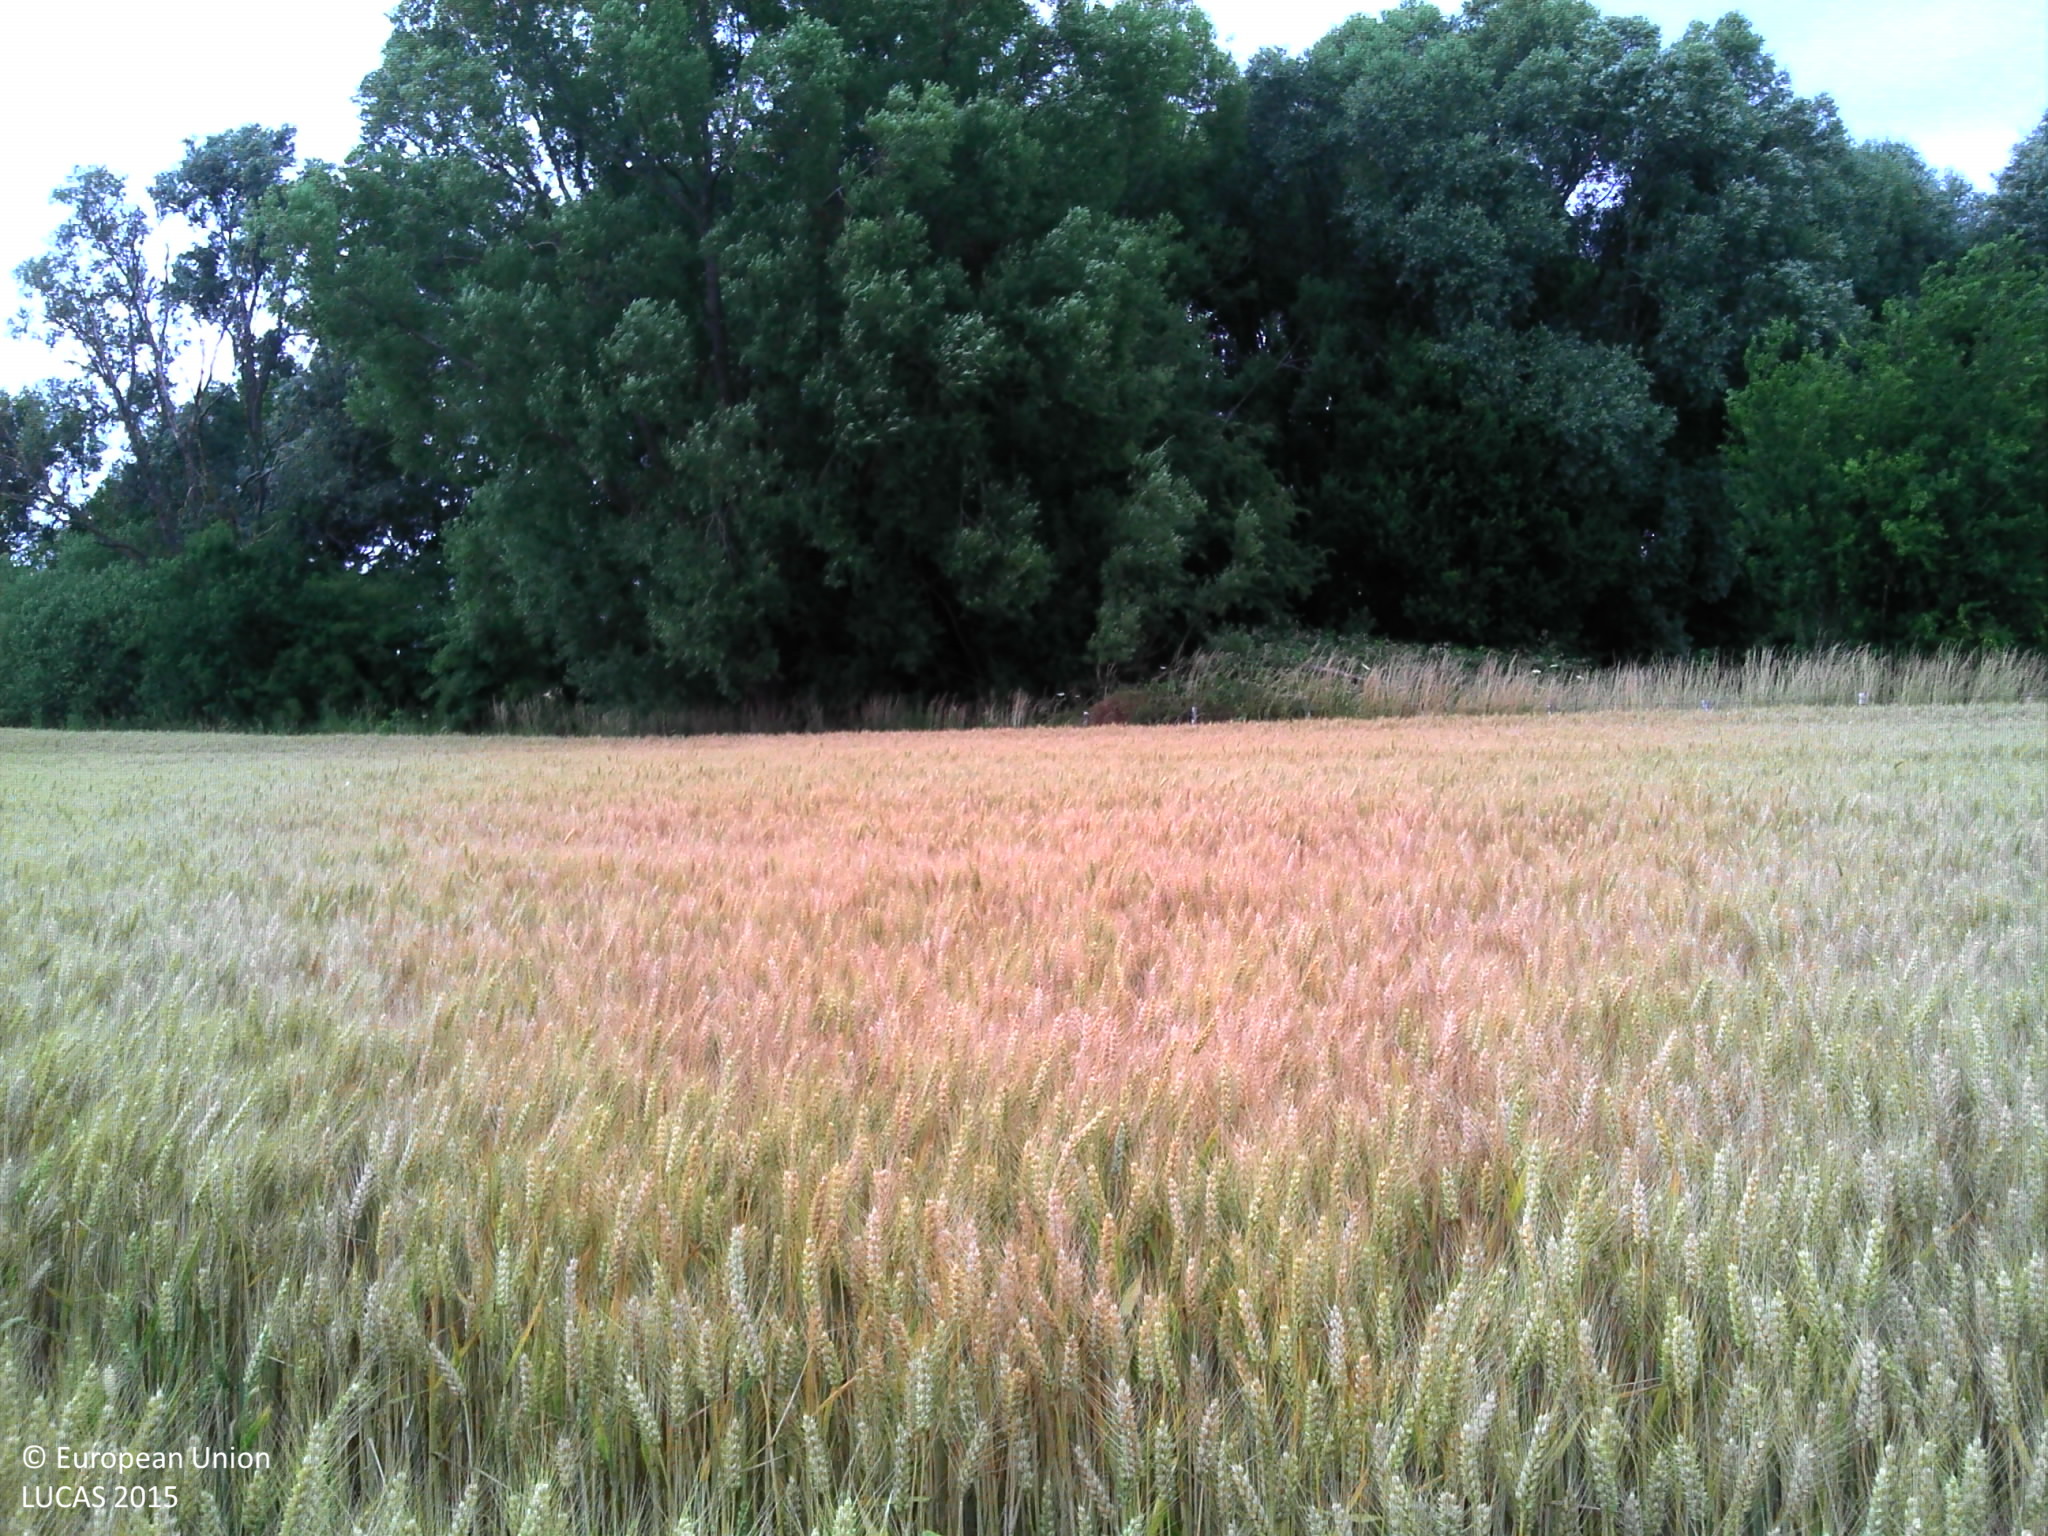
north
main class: Cropland
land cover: Common wheat
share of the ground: > 75 %
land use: Agriculture (excluding fallow land and kitchen gardens)
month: July
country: FR
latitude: 50.7700
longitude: 3.1134
